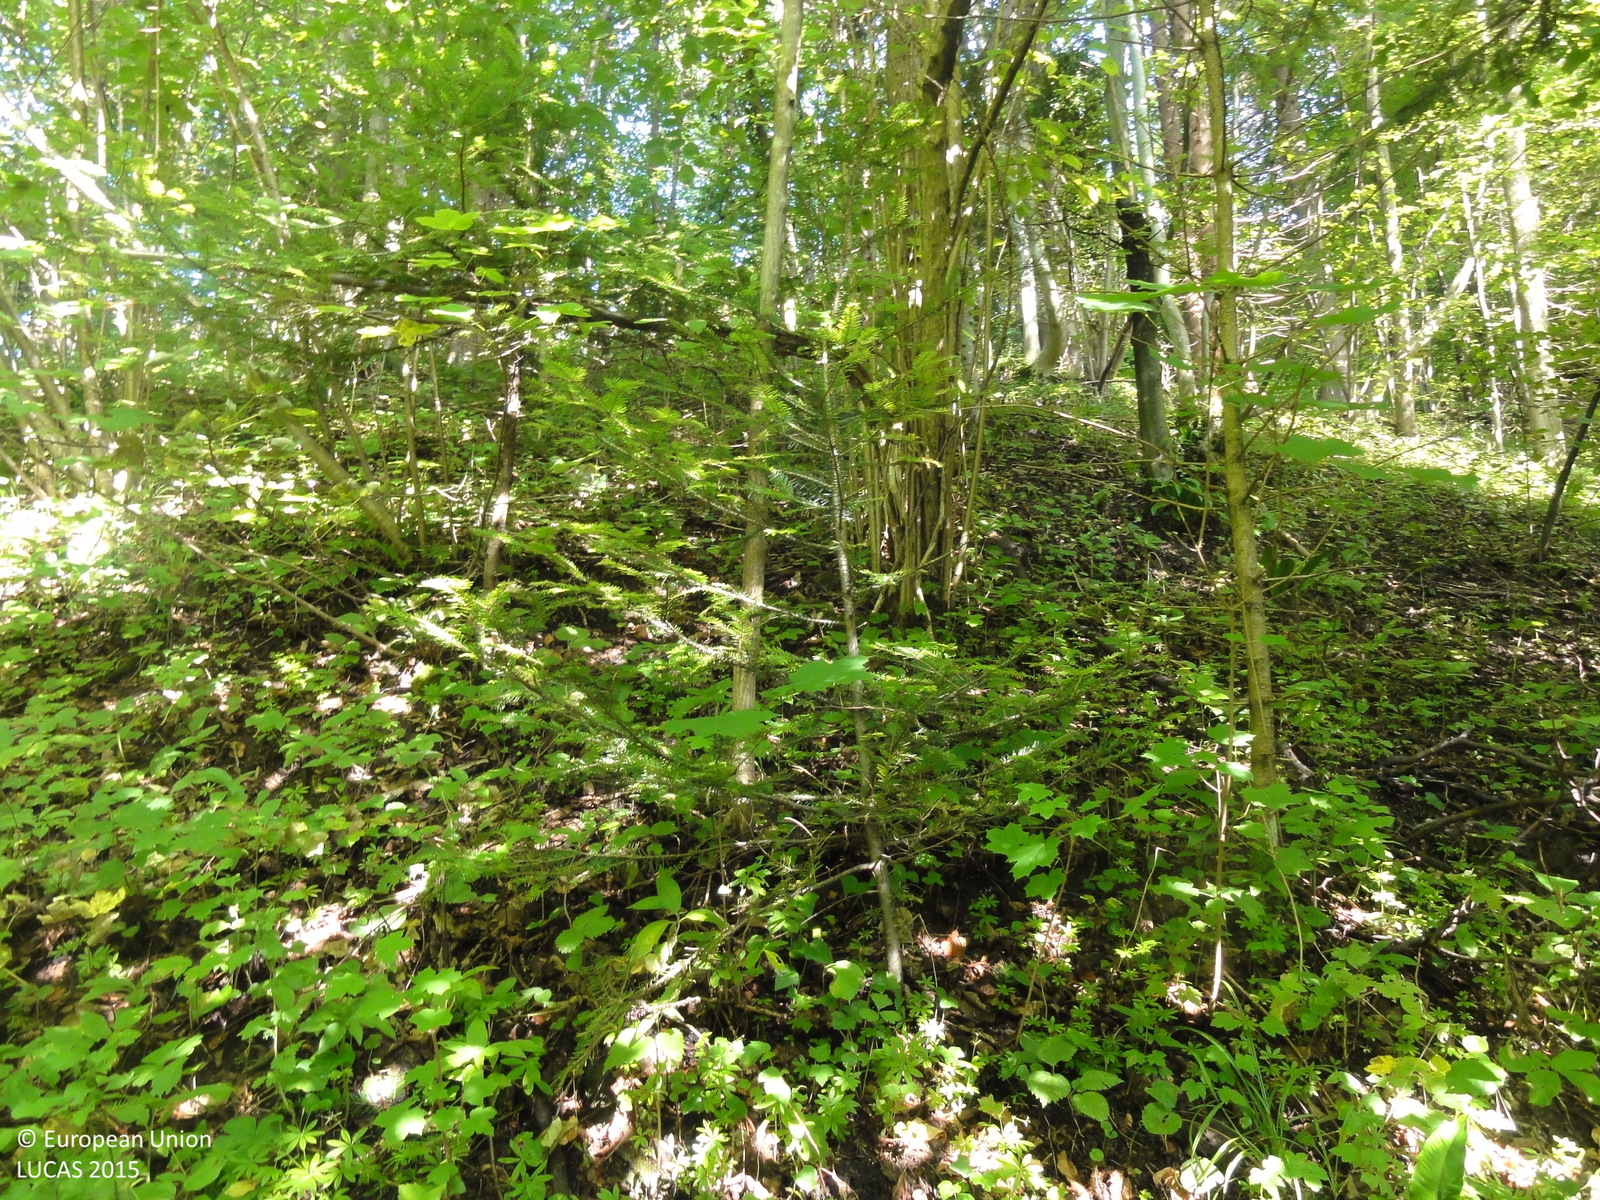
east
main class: Woodland
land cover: Broadleaved woodland
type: beech forest
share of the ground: 50 - 75 %
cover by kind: broadleaved forest trees 65 %, shrubs 20 %, herbaceous plants 10 %, coniferous forest trees 5 %
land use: Forestry
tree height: > 5 m
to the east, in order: Broadleaved woodland; Tracks; Broadleaved woodland; Tracks; Broadleaved woodland
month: August
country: SI
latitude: 46.1030
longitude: 15.4698
